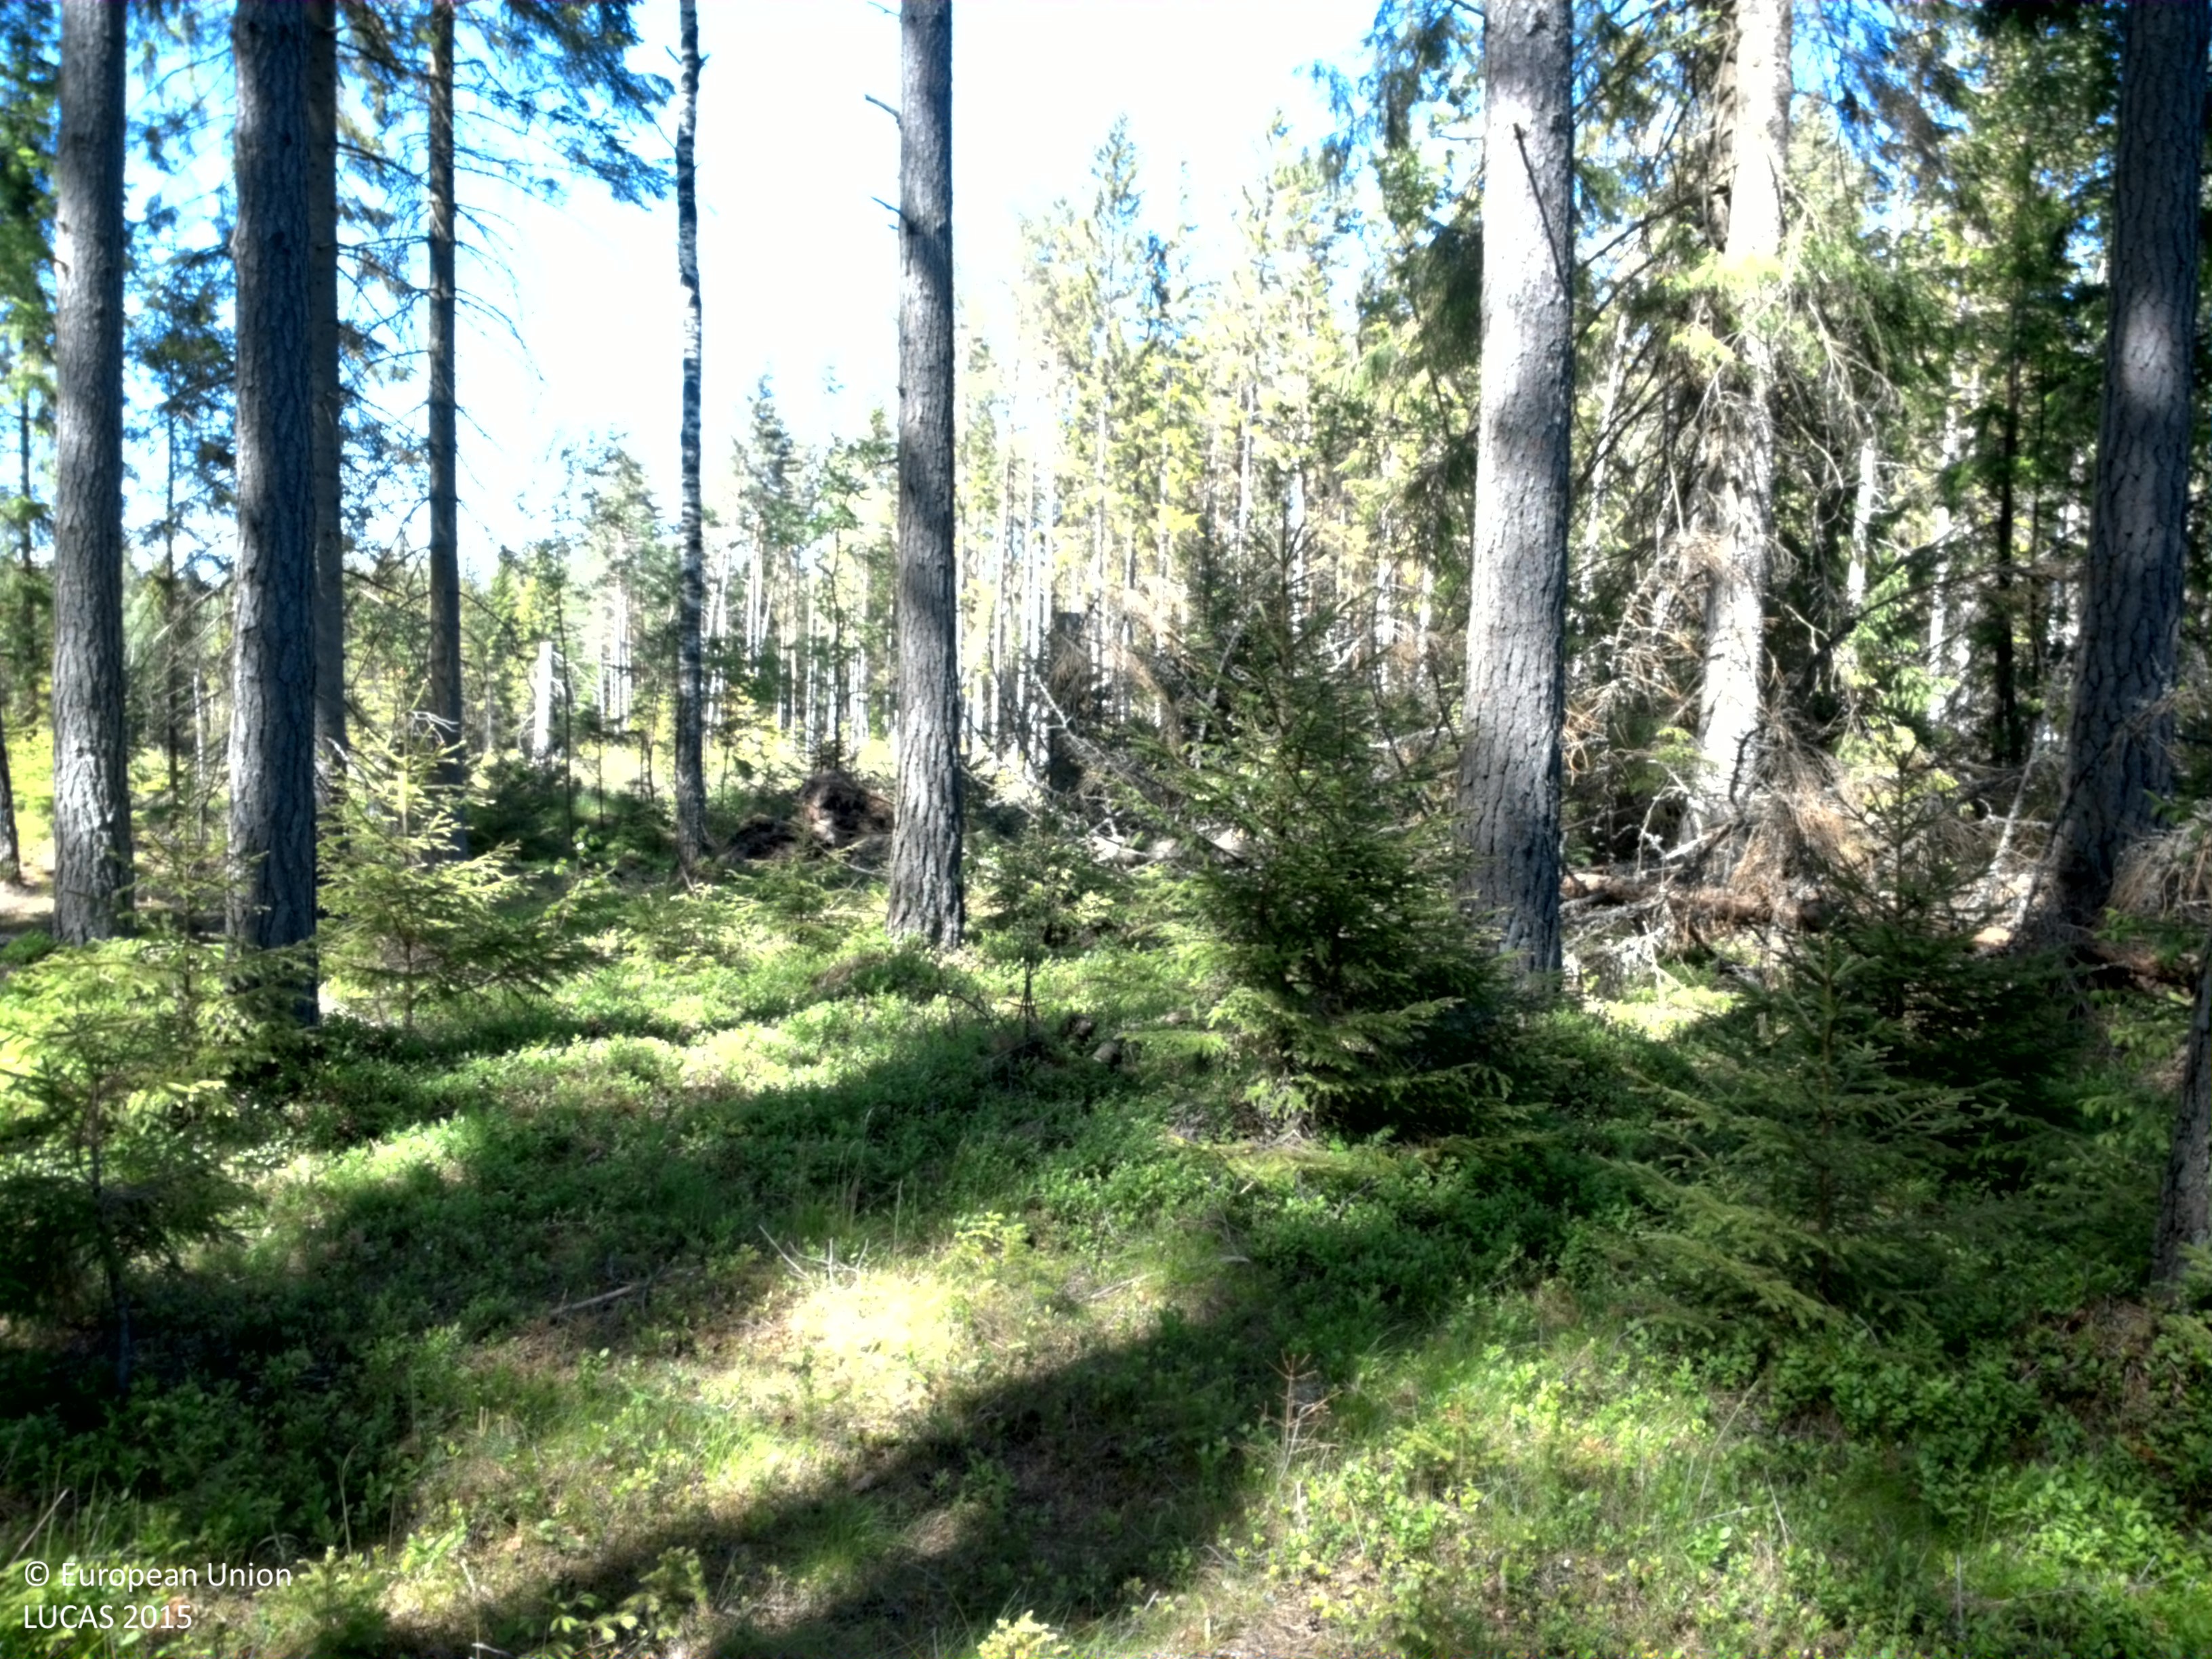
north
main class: Woodland
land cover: Pine dominated coniferous woodland
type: boreal forest
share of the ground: 50 - 75 %
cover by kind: coniferous forest trees 75 %, shrubs 20 %, lichens and mosses 5 %
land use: Forestry
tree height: > 5 m
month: June
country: SE
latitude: 58.4486
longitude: 13.9859
